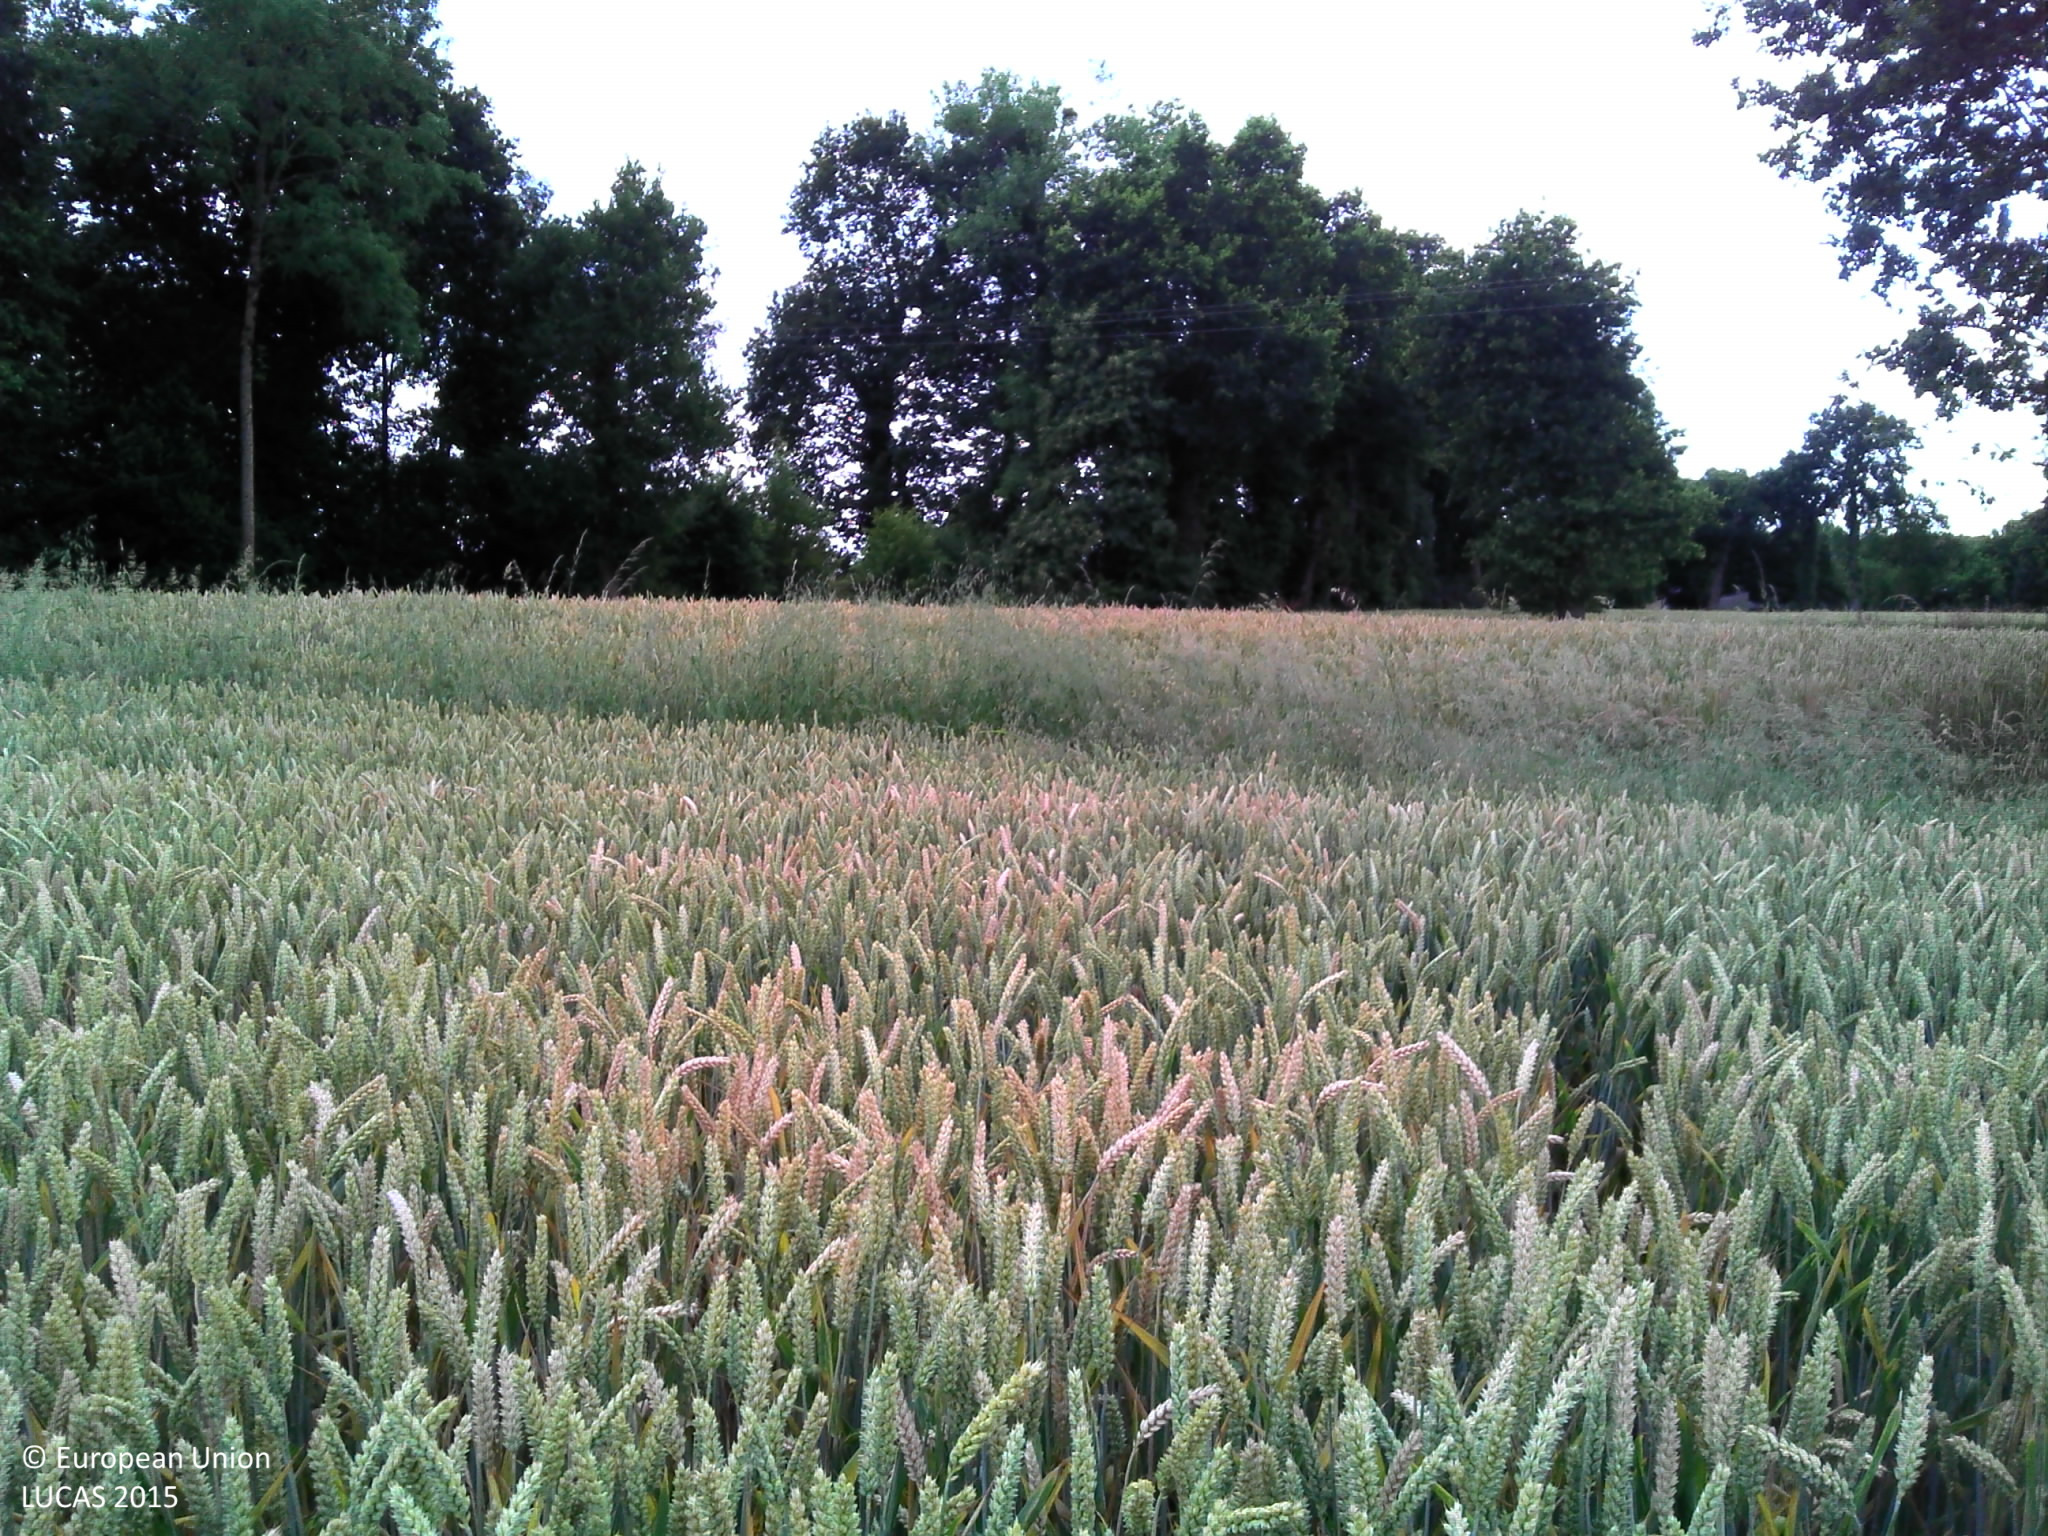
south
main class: Cropland
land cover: Common wheat
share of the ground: > 75 %
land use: Agriculture (excluding fallow land and kitchen gardens)
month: July
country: FR
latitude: 48.2802
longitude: -2.1156
